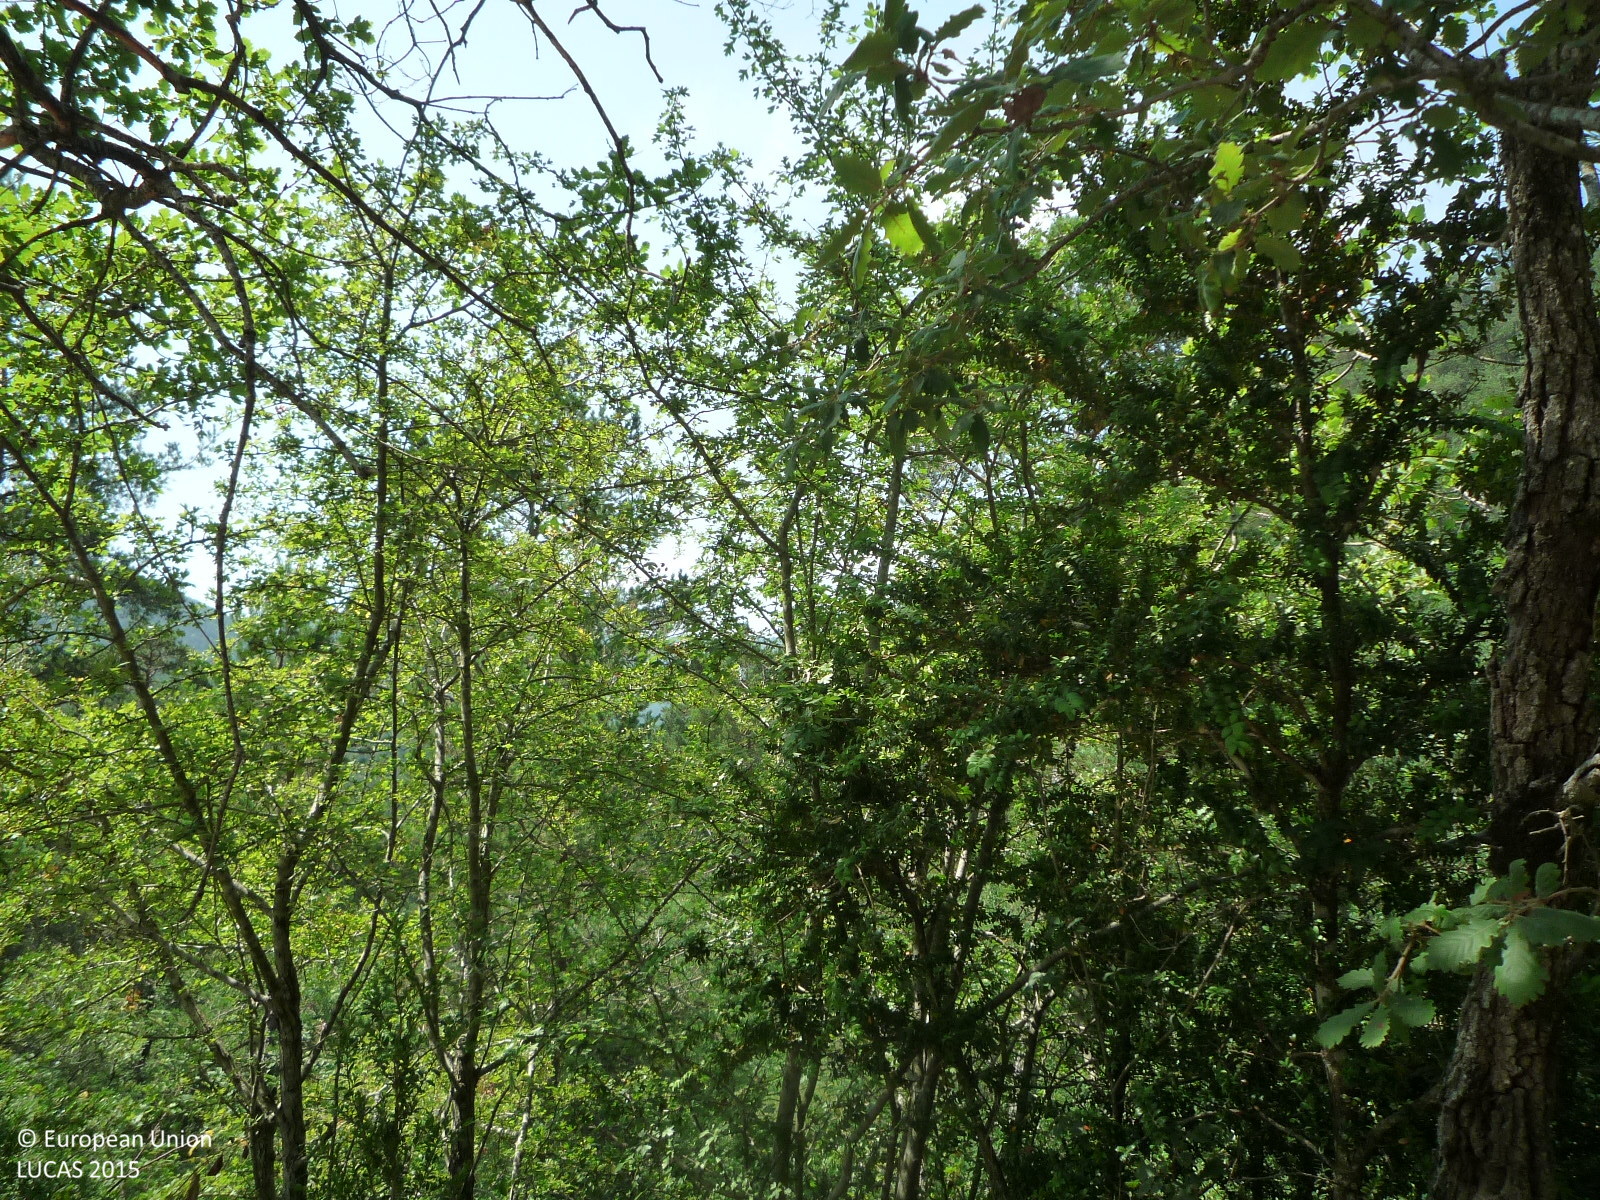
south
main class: Woodland
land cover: Pine dominated mixed woodland
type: coniferous forest of the mediterranean region
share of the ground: > 75 %
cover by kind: coniferous forest trees 55 %, broadleaved forest trees 45 %
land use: Semi-natural and natural areas not in use
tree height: > 5 m
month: July
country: ES
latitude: 42.1710
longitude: 1.9628
